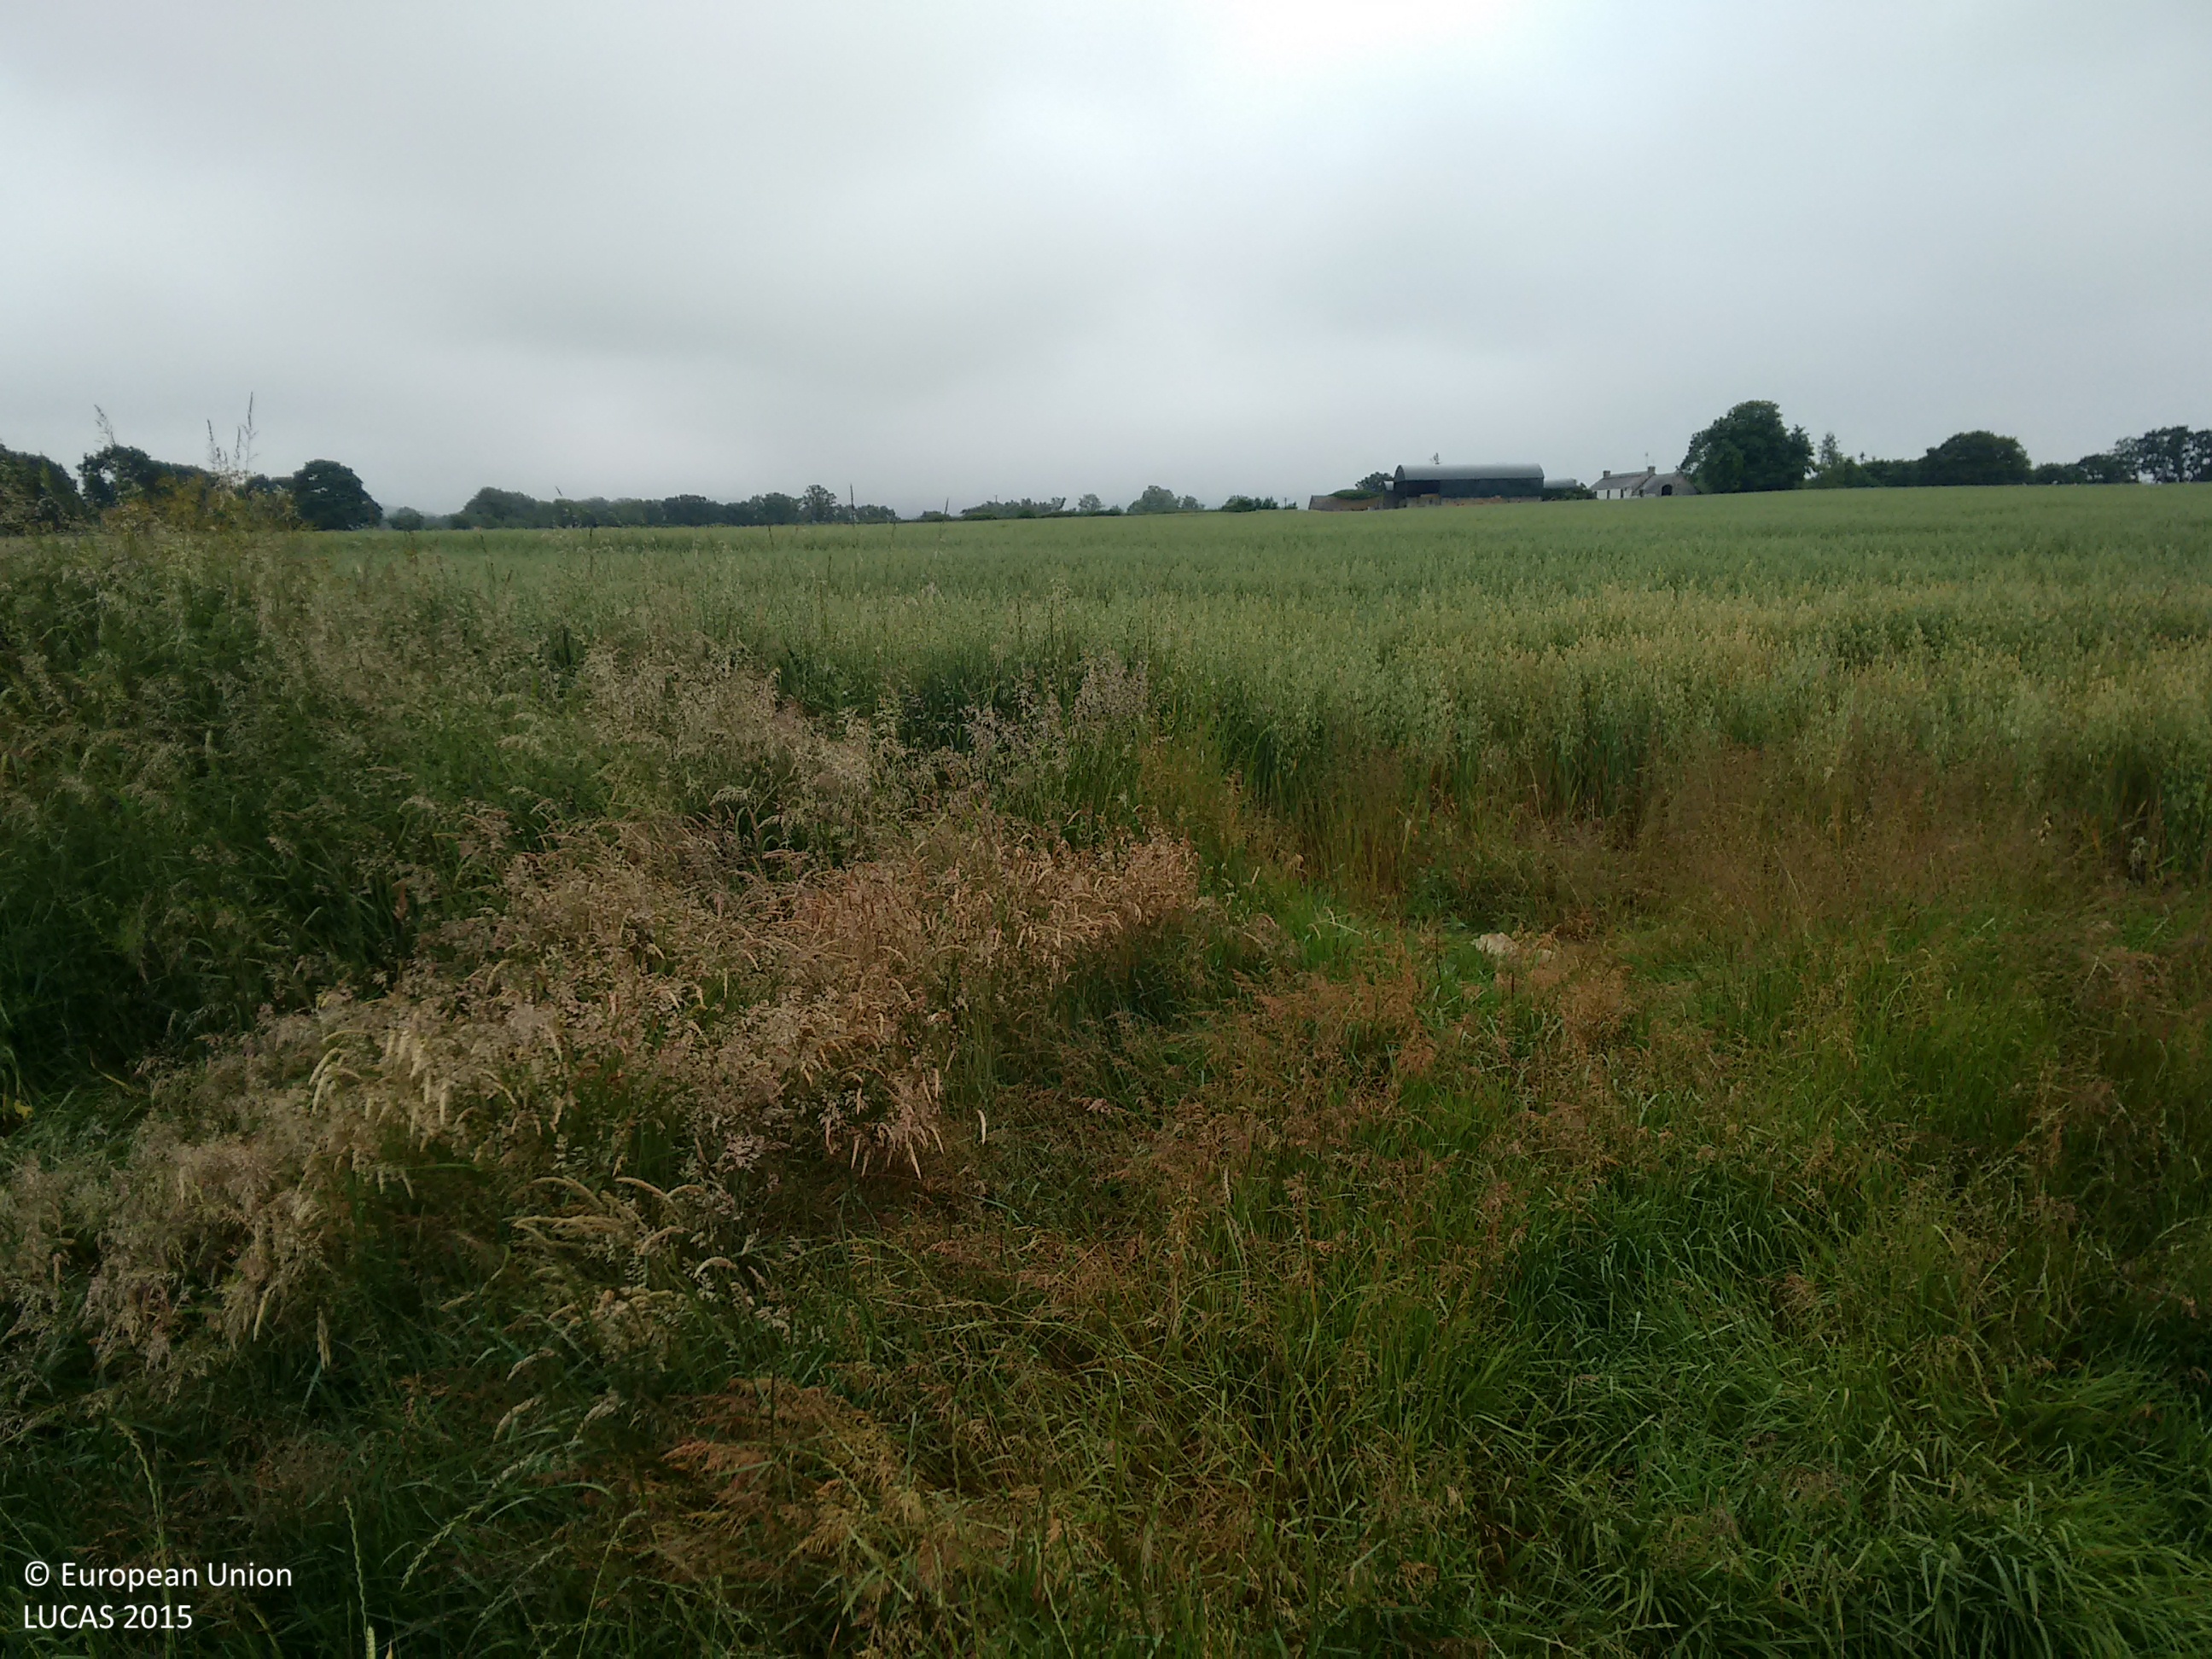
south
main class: Cropland
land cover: Dry pulses
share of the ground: > 75 %
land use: Agriculture (excluding fallow land and kitchen gardens)
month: June
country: IE
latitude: 52.4951
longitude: -7.2818
